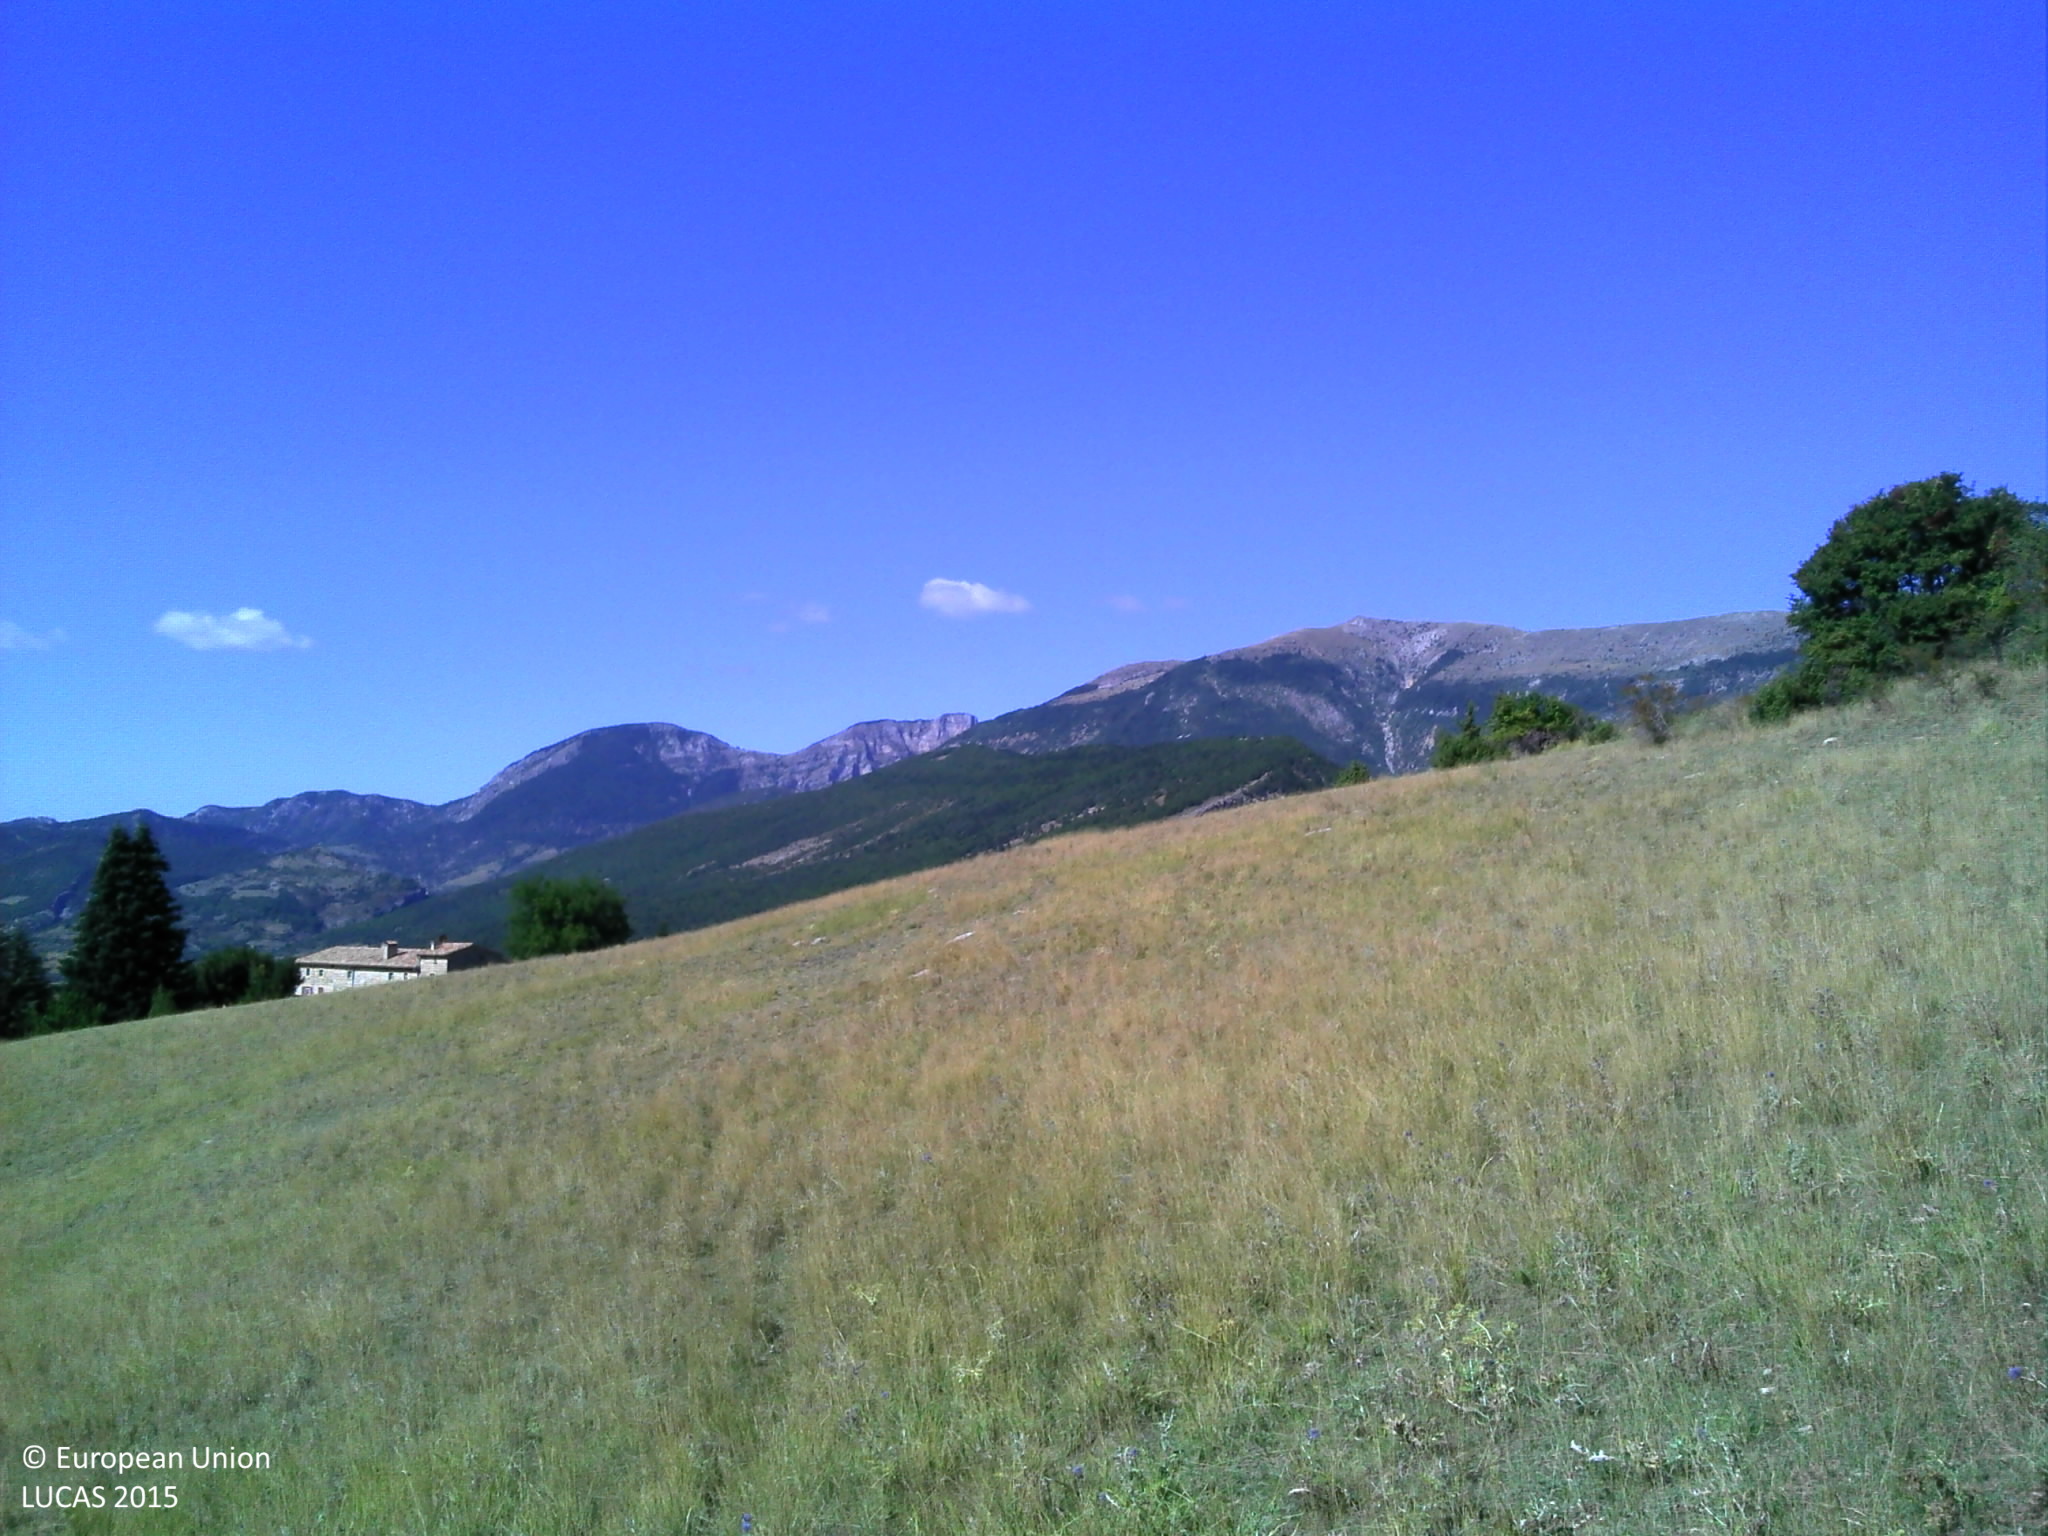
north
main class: Grassland
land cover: Grassland without tree/shrub cover
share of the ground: > 75 %
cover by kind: herbaceous plants 95 %, shrubs 5 %
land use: Agriculture (excluding fallow land and kitchen gardens)
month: September
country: FR
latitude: 44.5639
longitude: 5.1846
